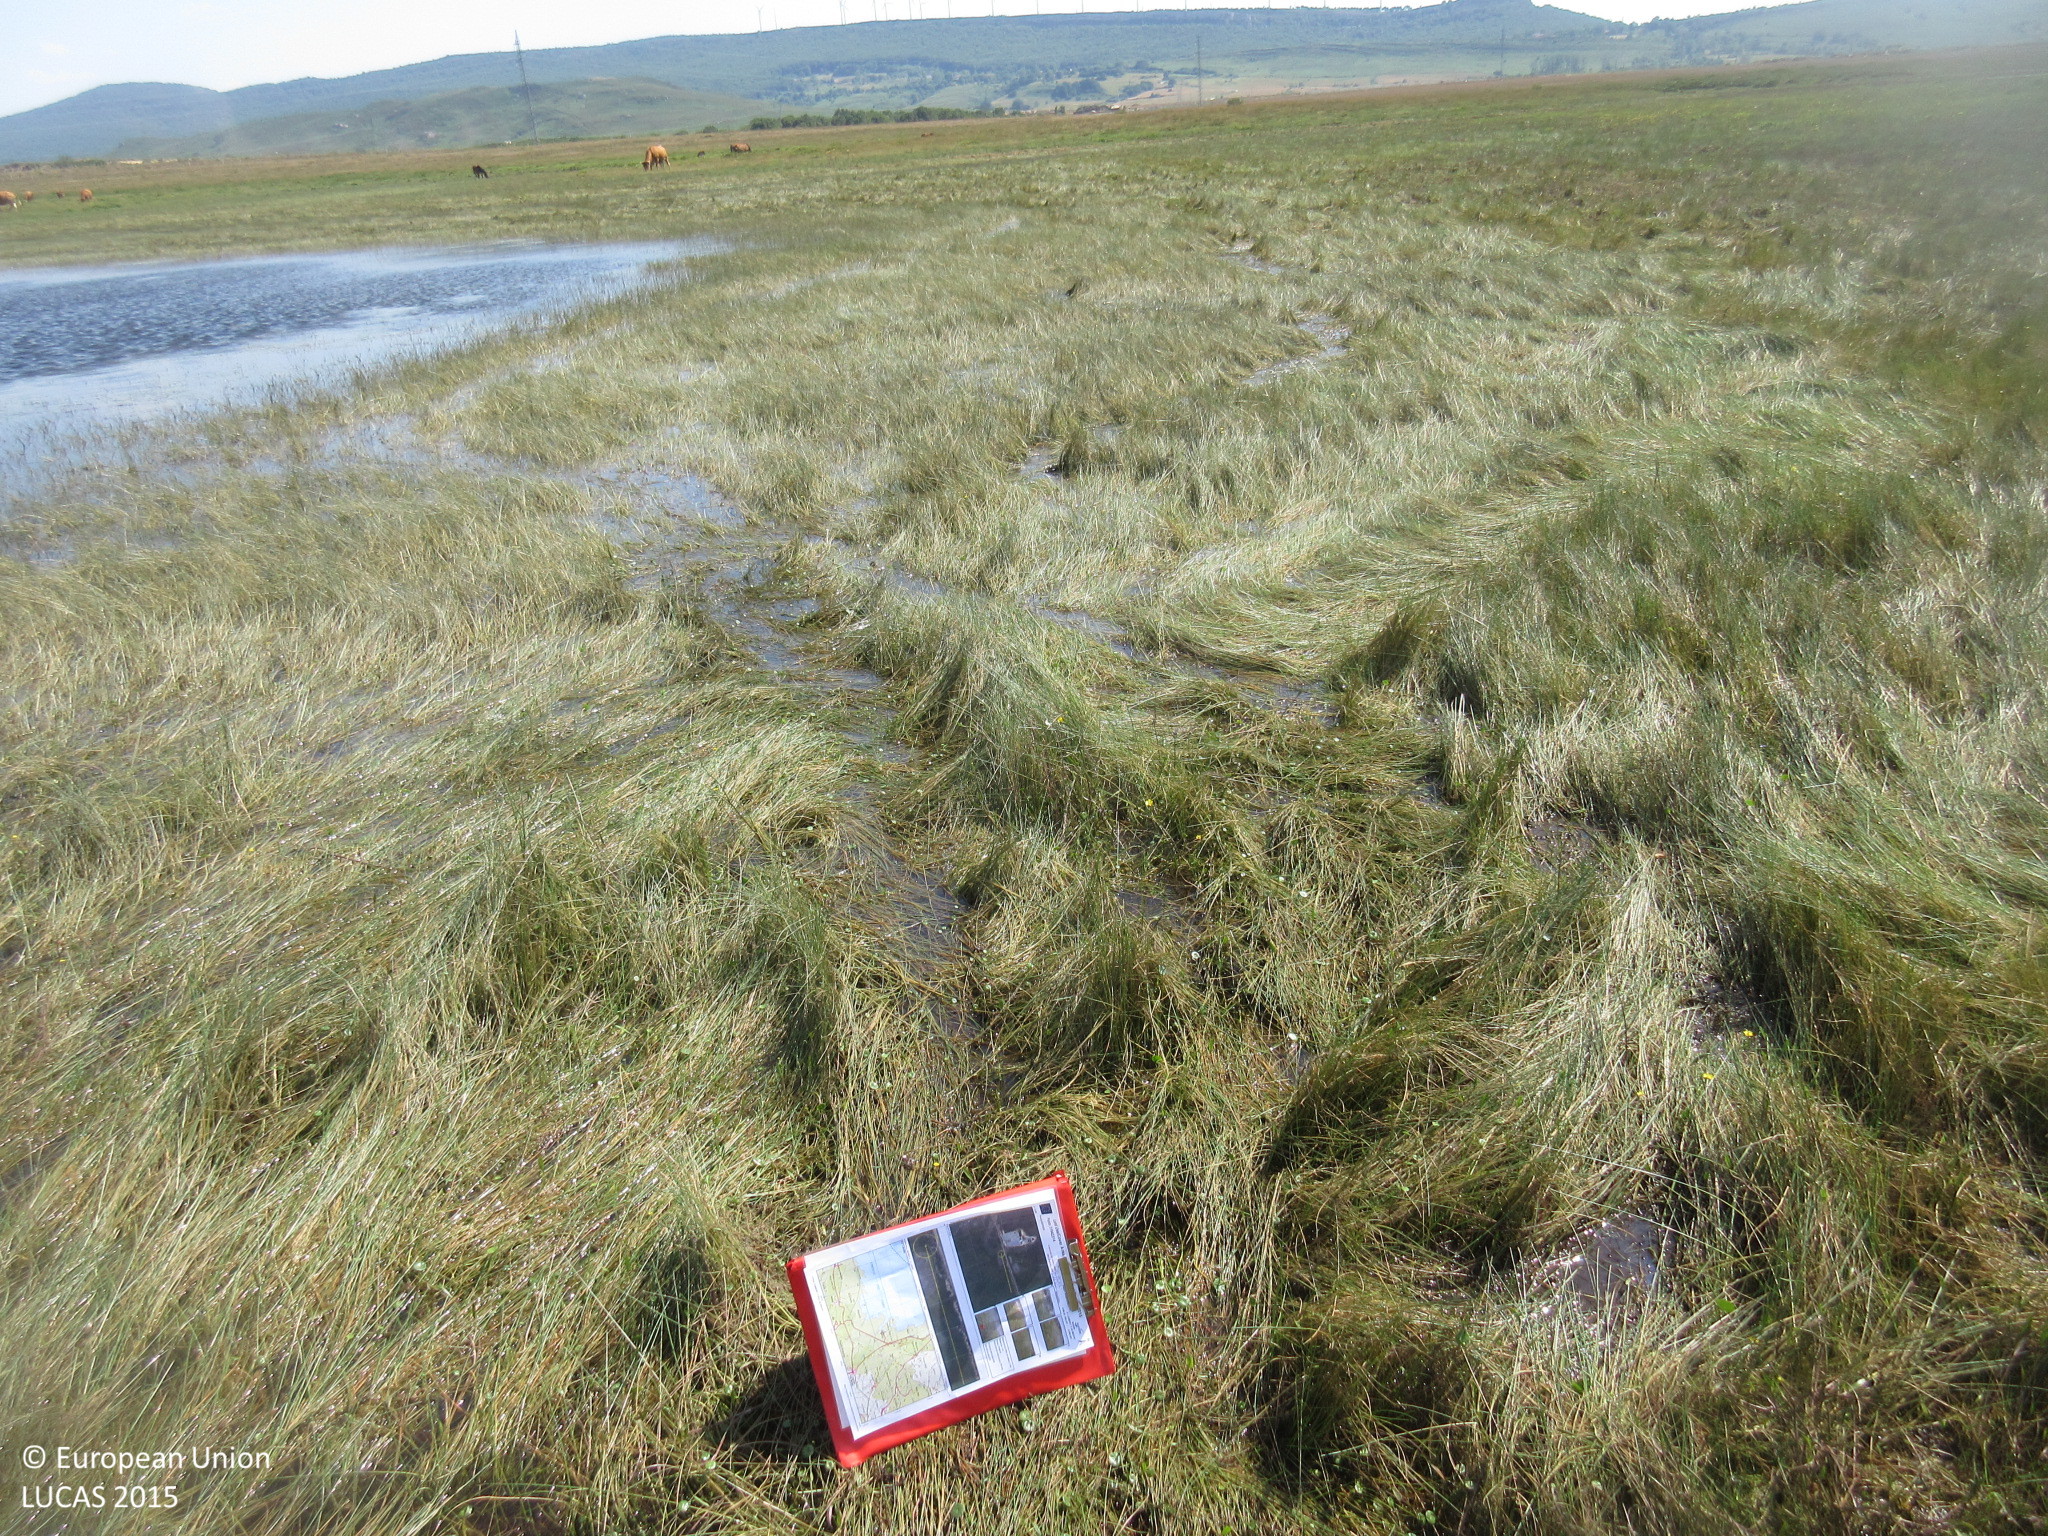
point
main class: Grassland
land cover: Grassland without tree/shrub cover
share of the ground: > 75 %
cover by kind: herbaceous plants 100 %
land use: Agriculture (excluding fallow land and kitchen gardens)
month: July
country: ES
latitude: 42.9935
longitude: -3.8688
